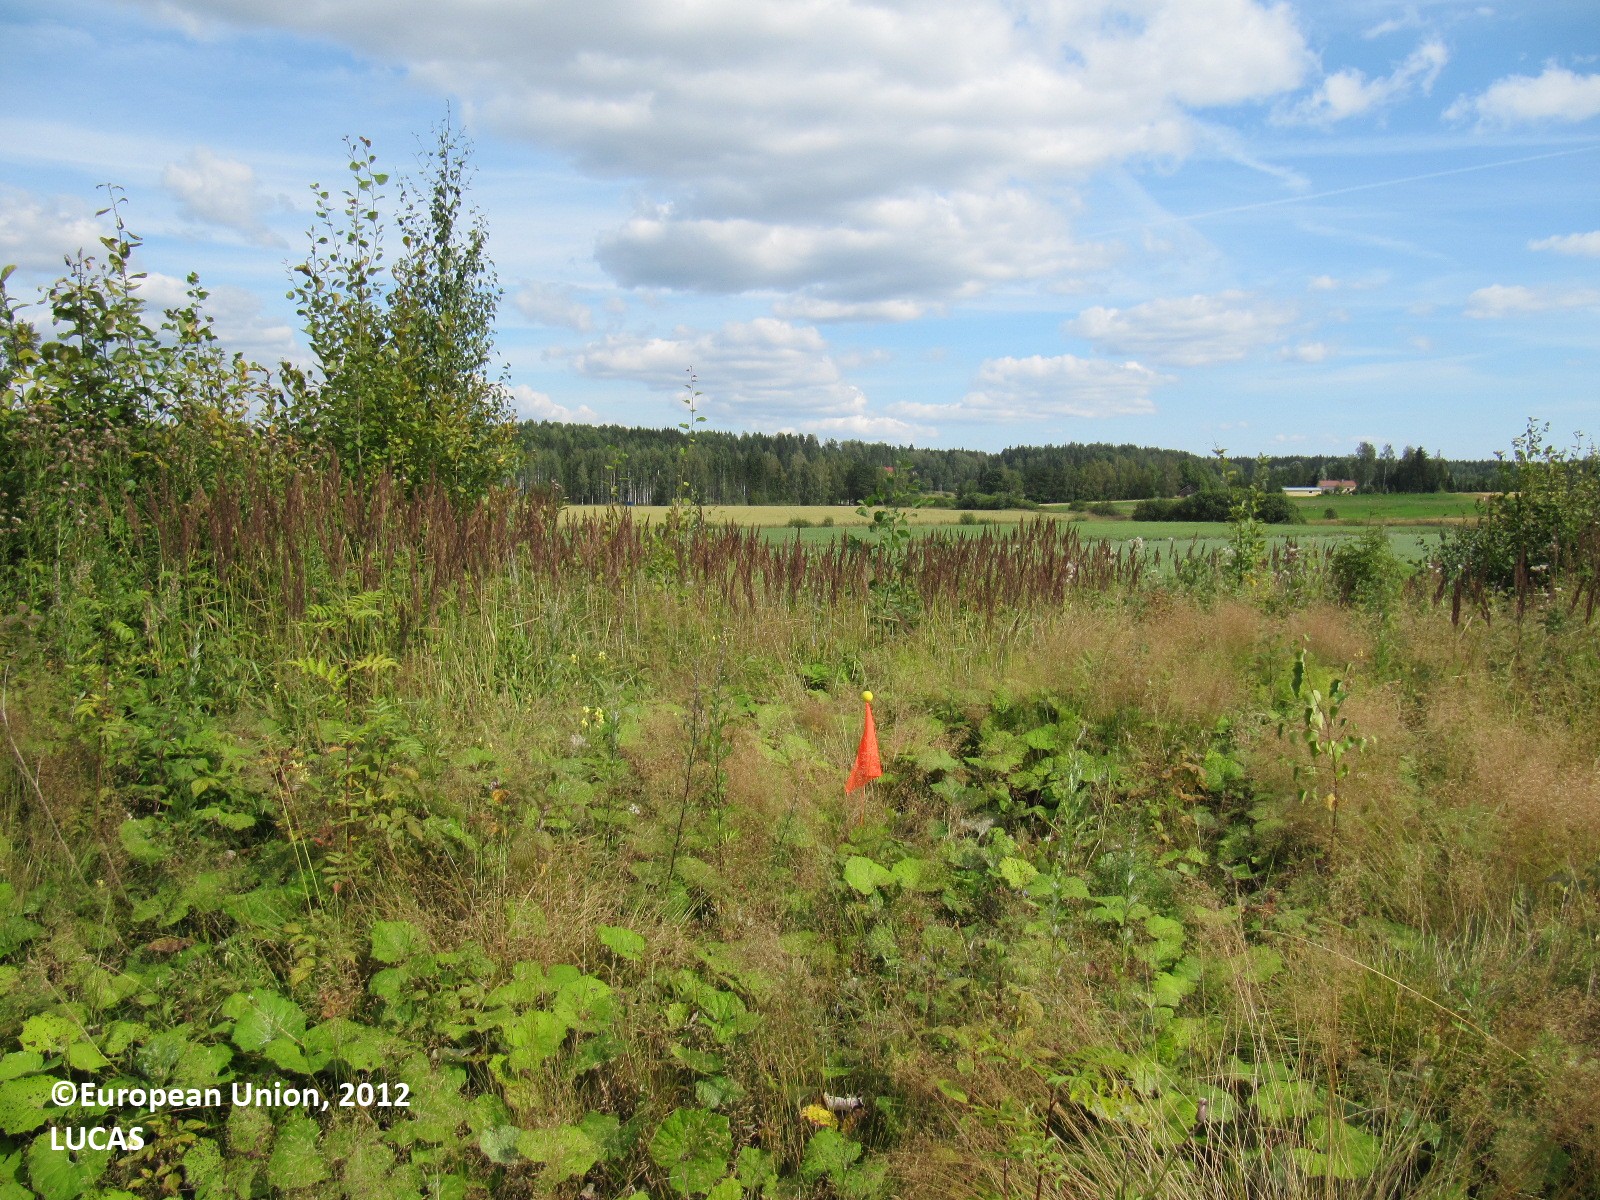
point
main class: Grassland
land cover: Grassland with sparse tree/shrub cover
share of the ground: > 75 %
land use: Semi-natural and natural areas not in use
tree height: < 5 m
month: August
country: FI
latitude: 60.3815
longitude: 24.3063
